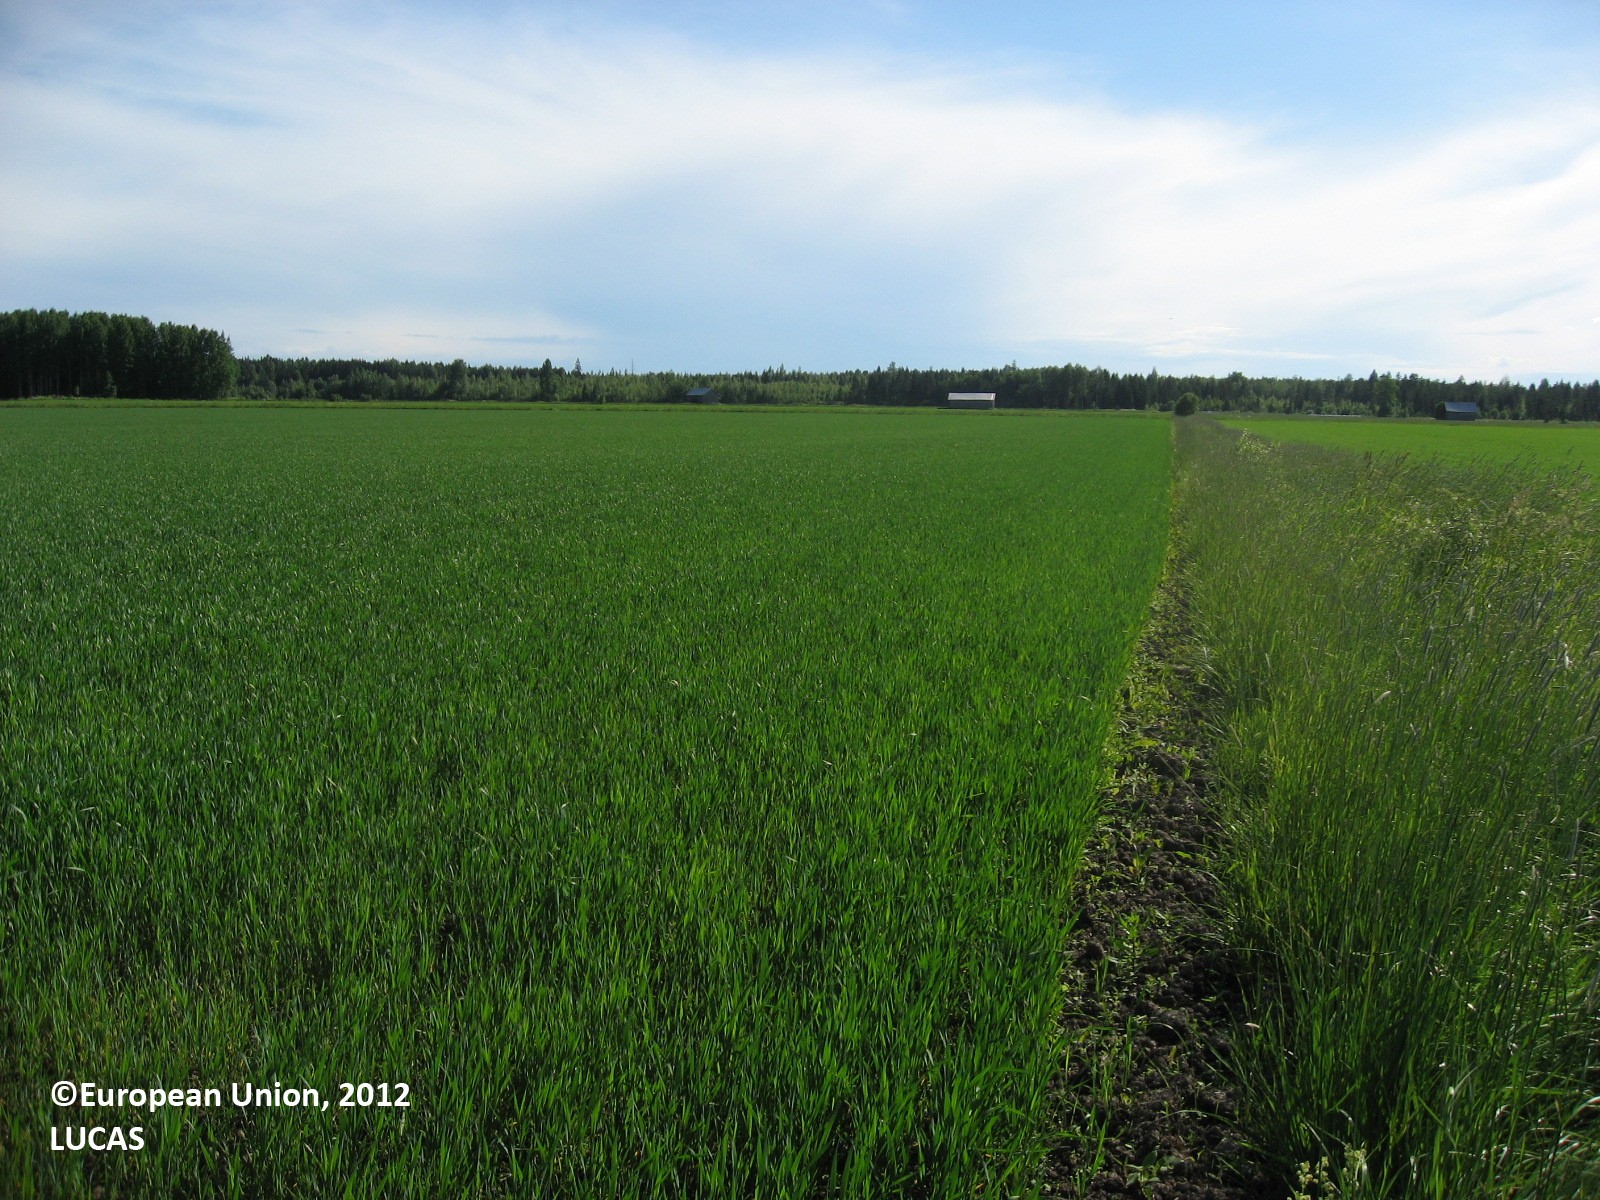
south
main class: Cropland
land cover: Common wheat
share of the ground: 50 - 75 %
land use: Agriculture (excluding fallow land and kitchen gardens)
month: June
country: FI
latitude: 60.5871
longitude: 26.3051
